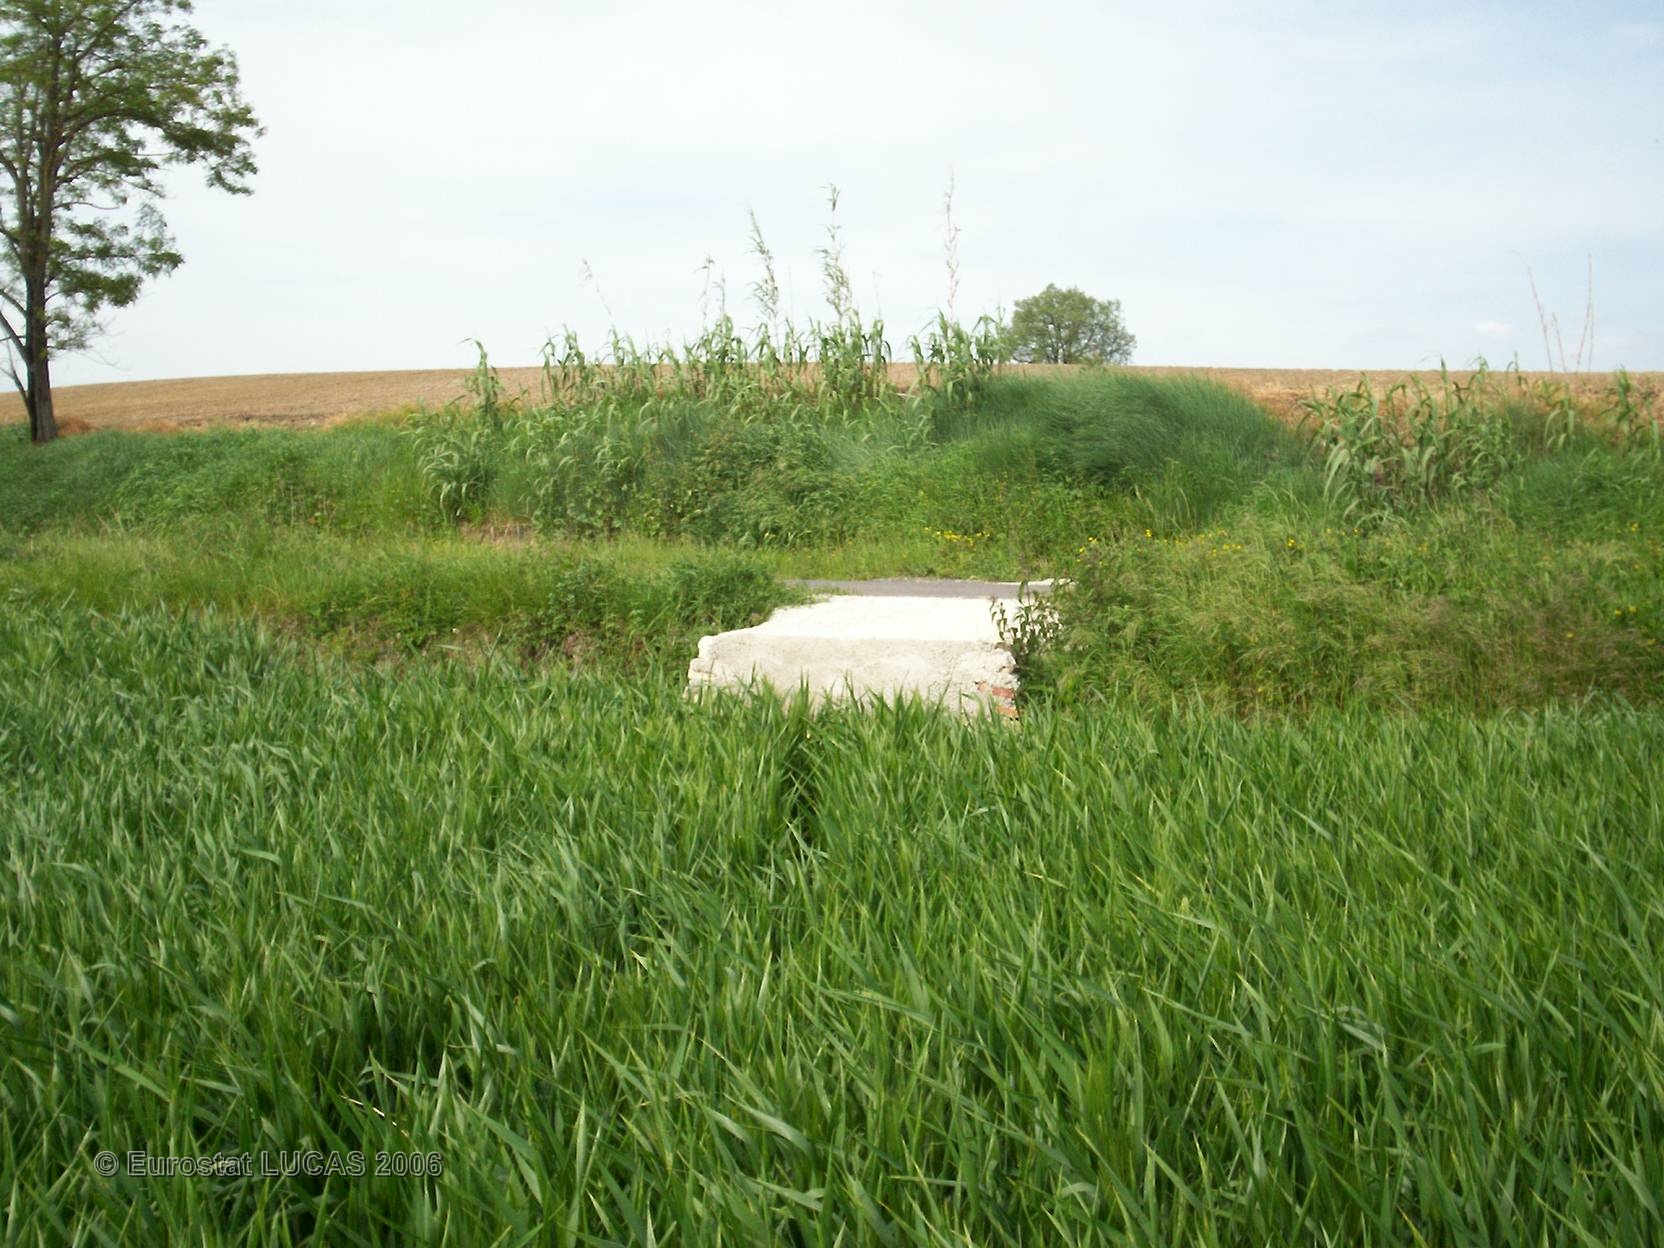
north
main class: Cropland
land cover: Durum wheat
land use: Agriculture (excluding fallow land and kitchen gardens)
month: May
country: FR
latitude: 43.8425
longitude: 2.0061
